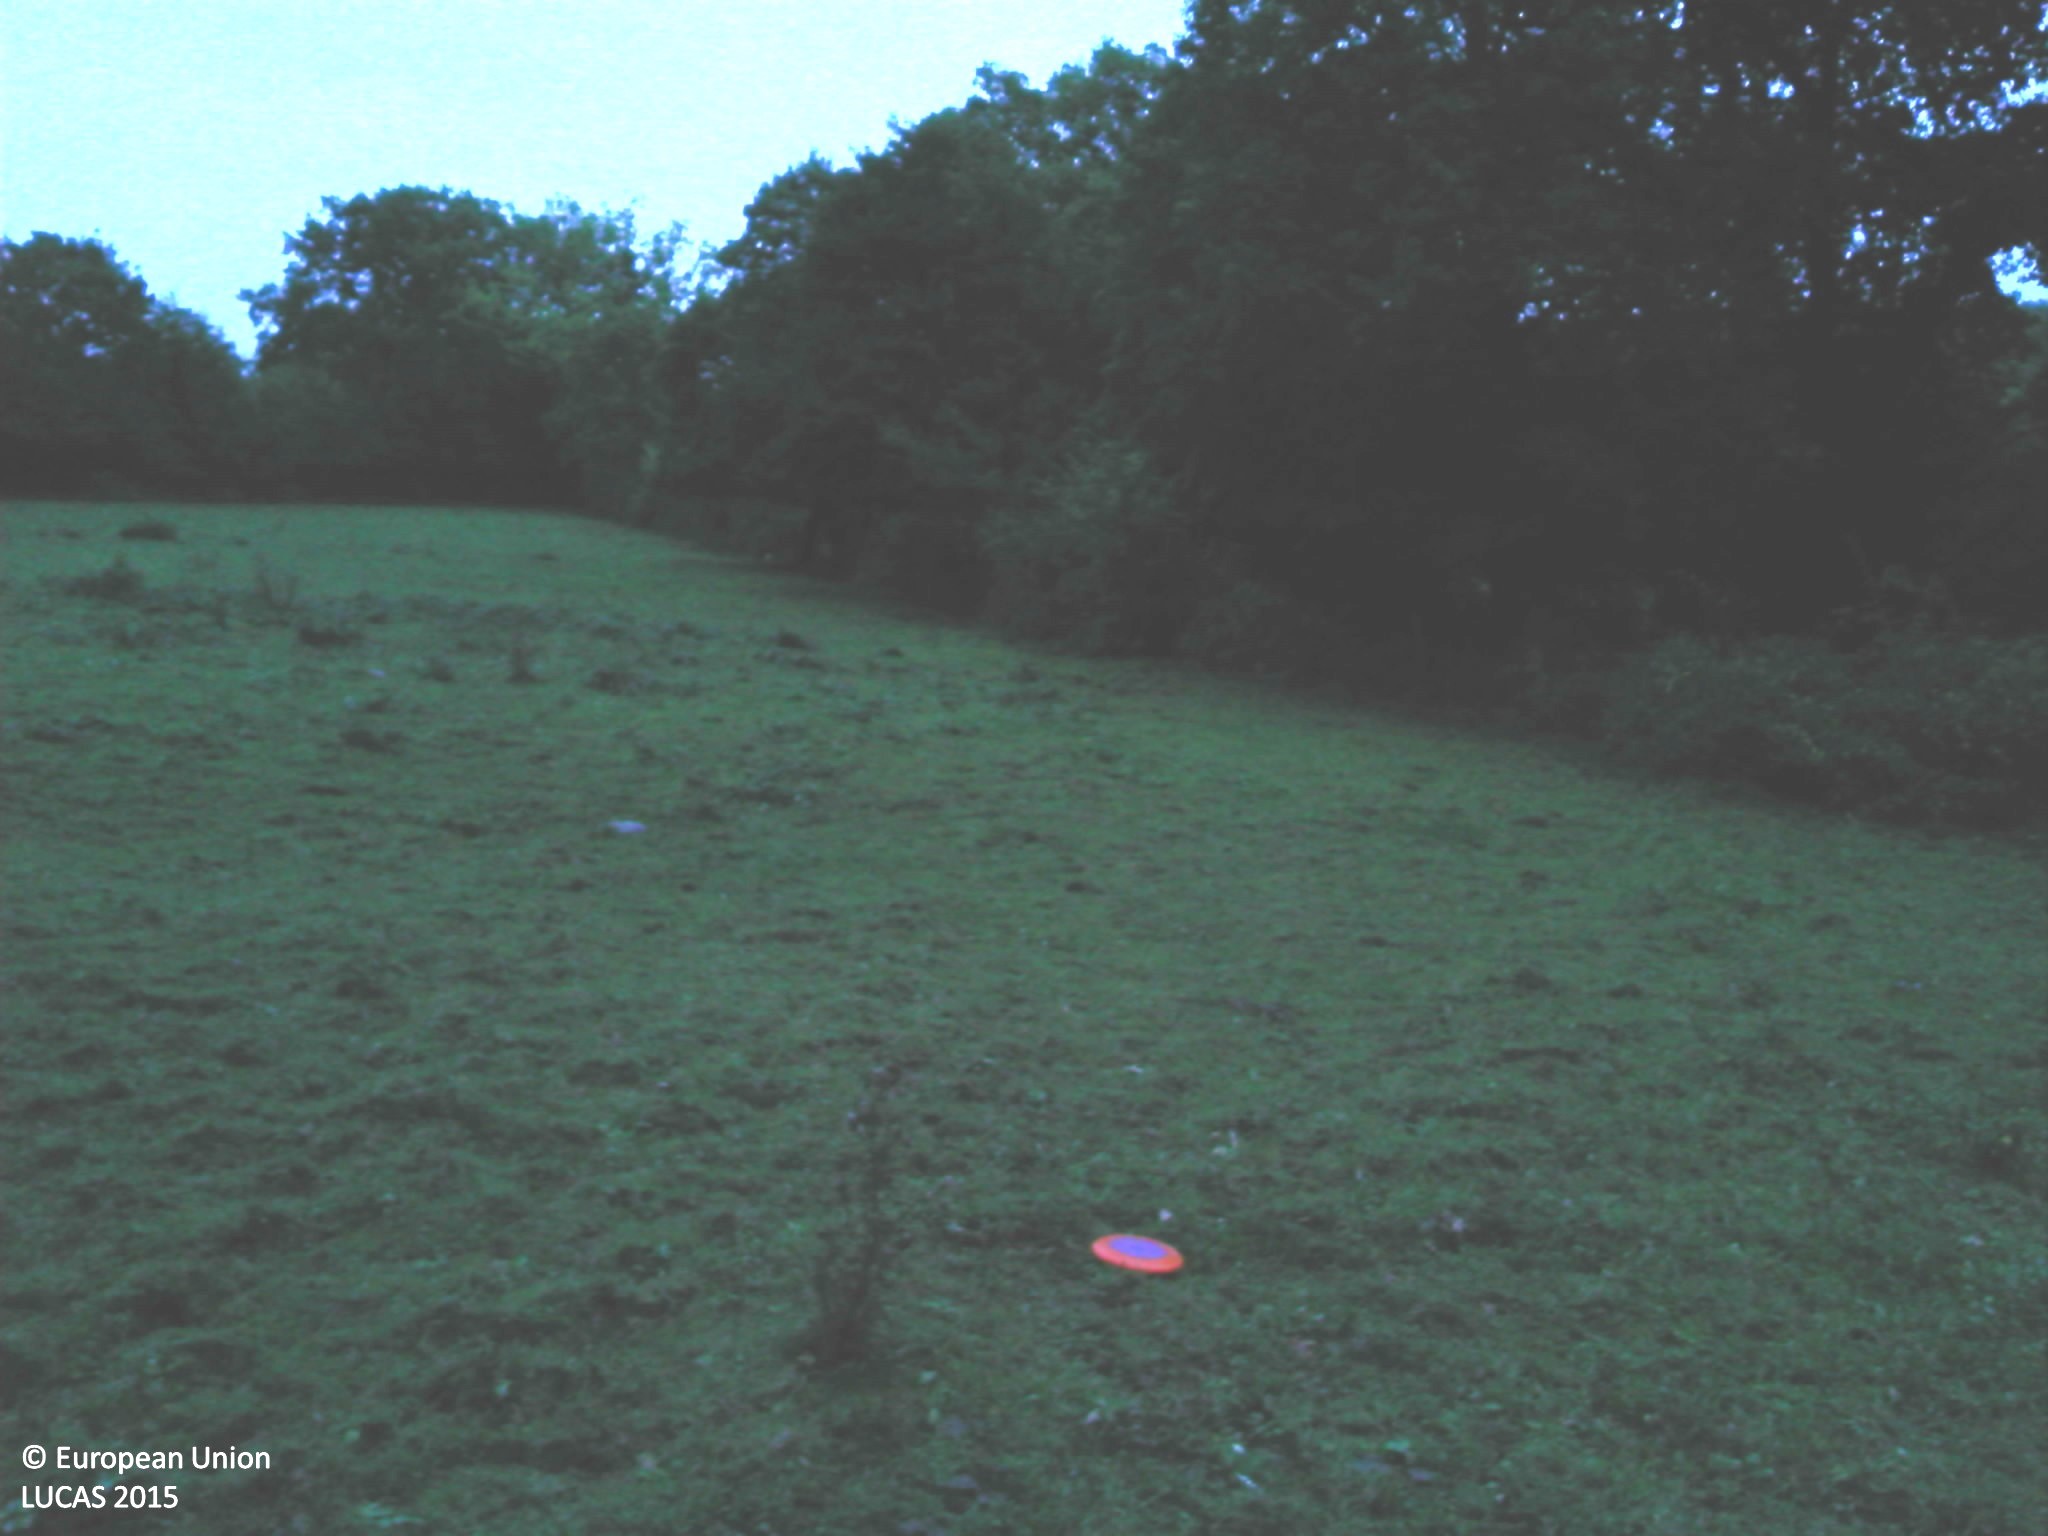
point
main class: Grassland
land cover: Grassland without tree/shrub cover
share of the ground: 50 - 75 %
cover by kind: herbaceous plants 70 %, unconsolidated bare surface 30 %
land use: Agriculture (excluding fallow land and kitchen gardens)
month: September
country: FR
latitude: 46.5457
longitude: 1.6047
